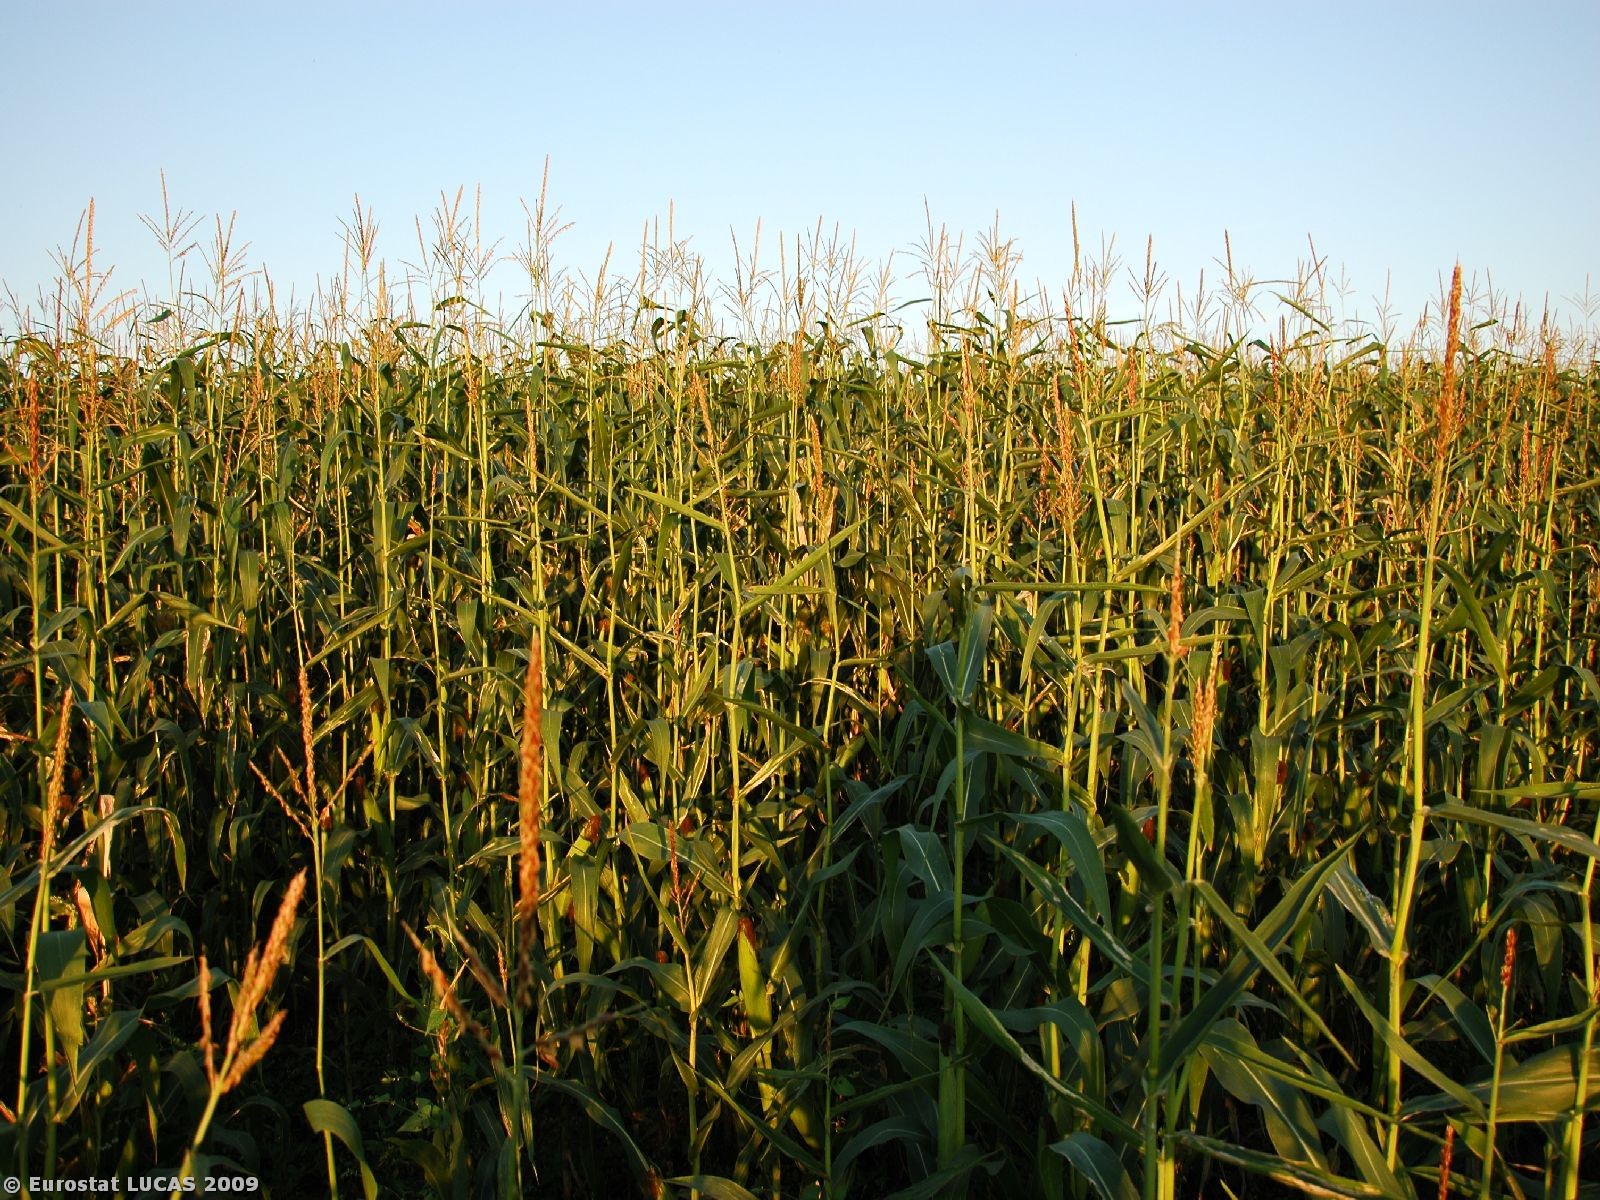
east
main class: Cropland
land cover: Maize
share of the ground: > 75 %
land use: Agriculture (excluding fallow land and kitchen gardens)
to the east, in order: Maize; Grassland without tree/shrub cover
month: August
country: PL
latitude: 49.7767
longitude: 18.7274
